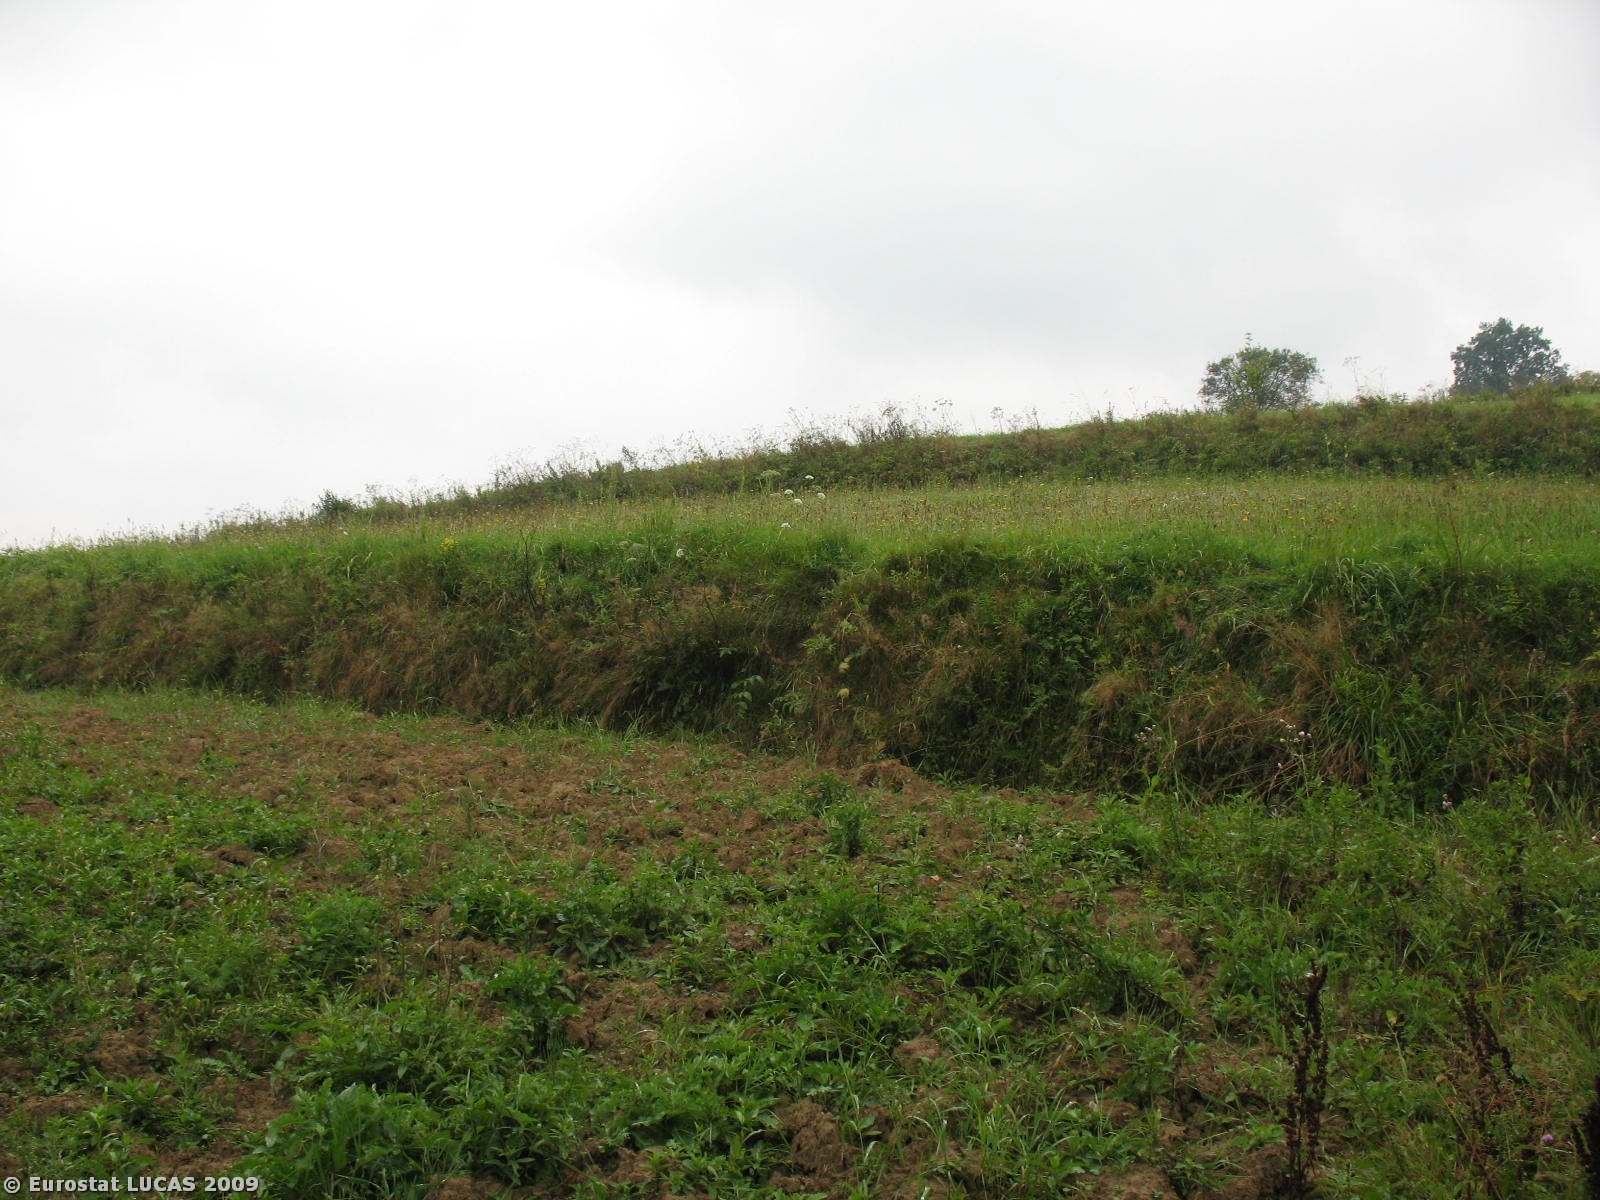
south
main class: Grassland
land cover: Spontaneously vegetated surfaces
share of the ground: > 75 %
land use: Fallow land
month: August
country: PL
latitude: 49.4076
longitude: 22.2854
